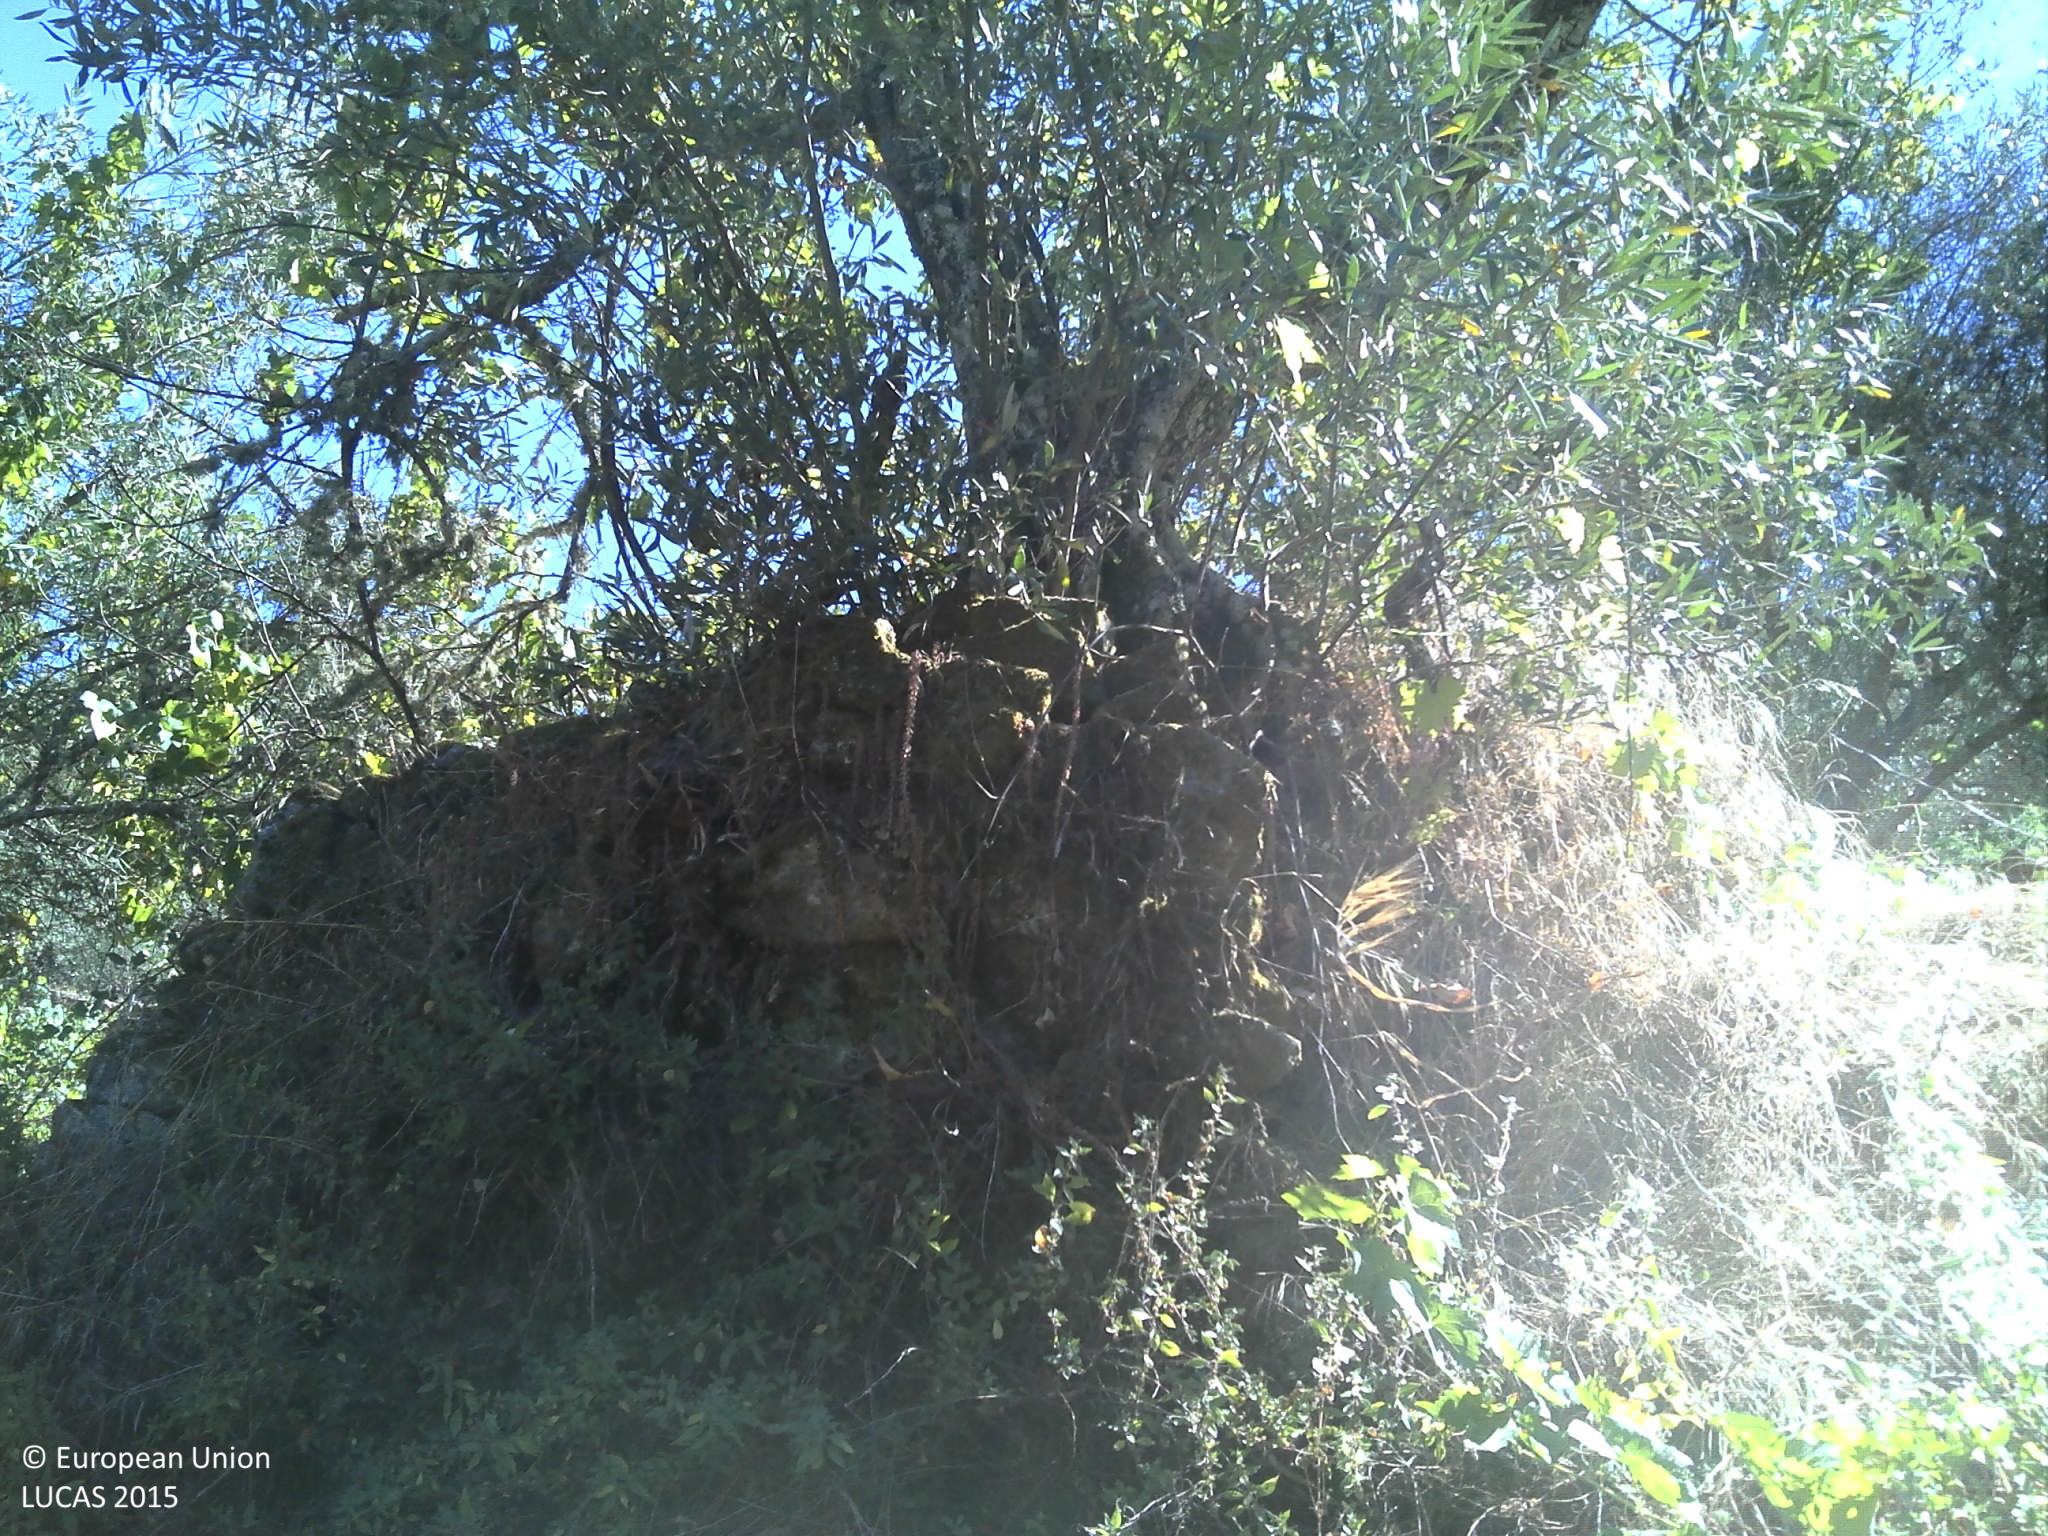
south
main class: Cropland
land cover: Olive groves
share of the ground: < 10 %
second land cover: Grassland without tree/shrub cover
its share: > 75 %
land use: Agriculture (excluding fallow land and kitchen gardens)
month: July
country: PT
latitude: 41.3038
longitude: -7.3794
